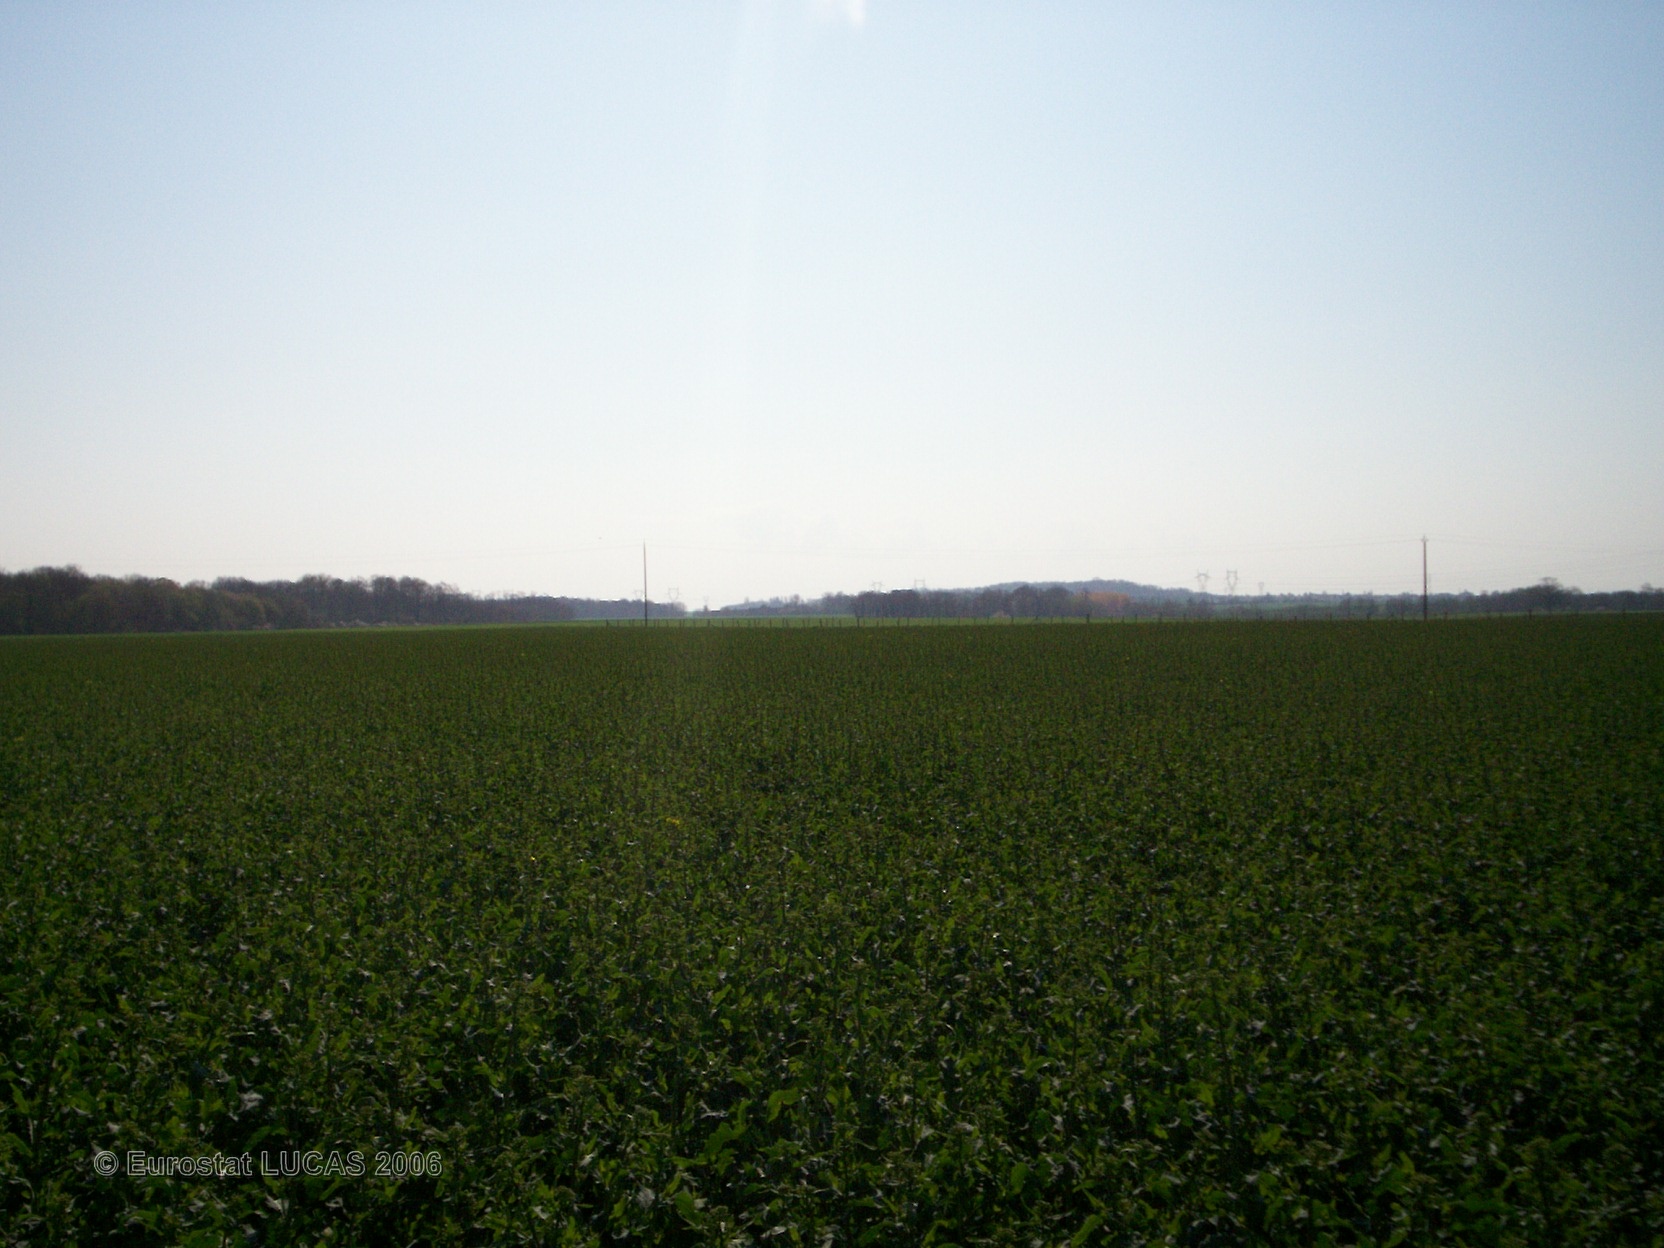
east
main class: Cropland
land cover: Rape and turnip rape
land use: Agriculture (excluding fallow land and kitchen gardens)
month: April
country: FR
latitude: 48.4081
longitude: 2.8720
